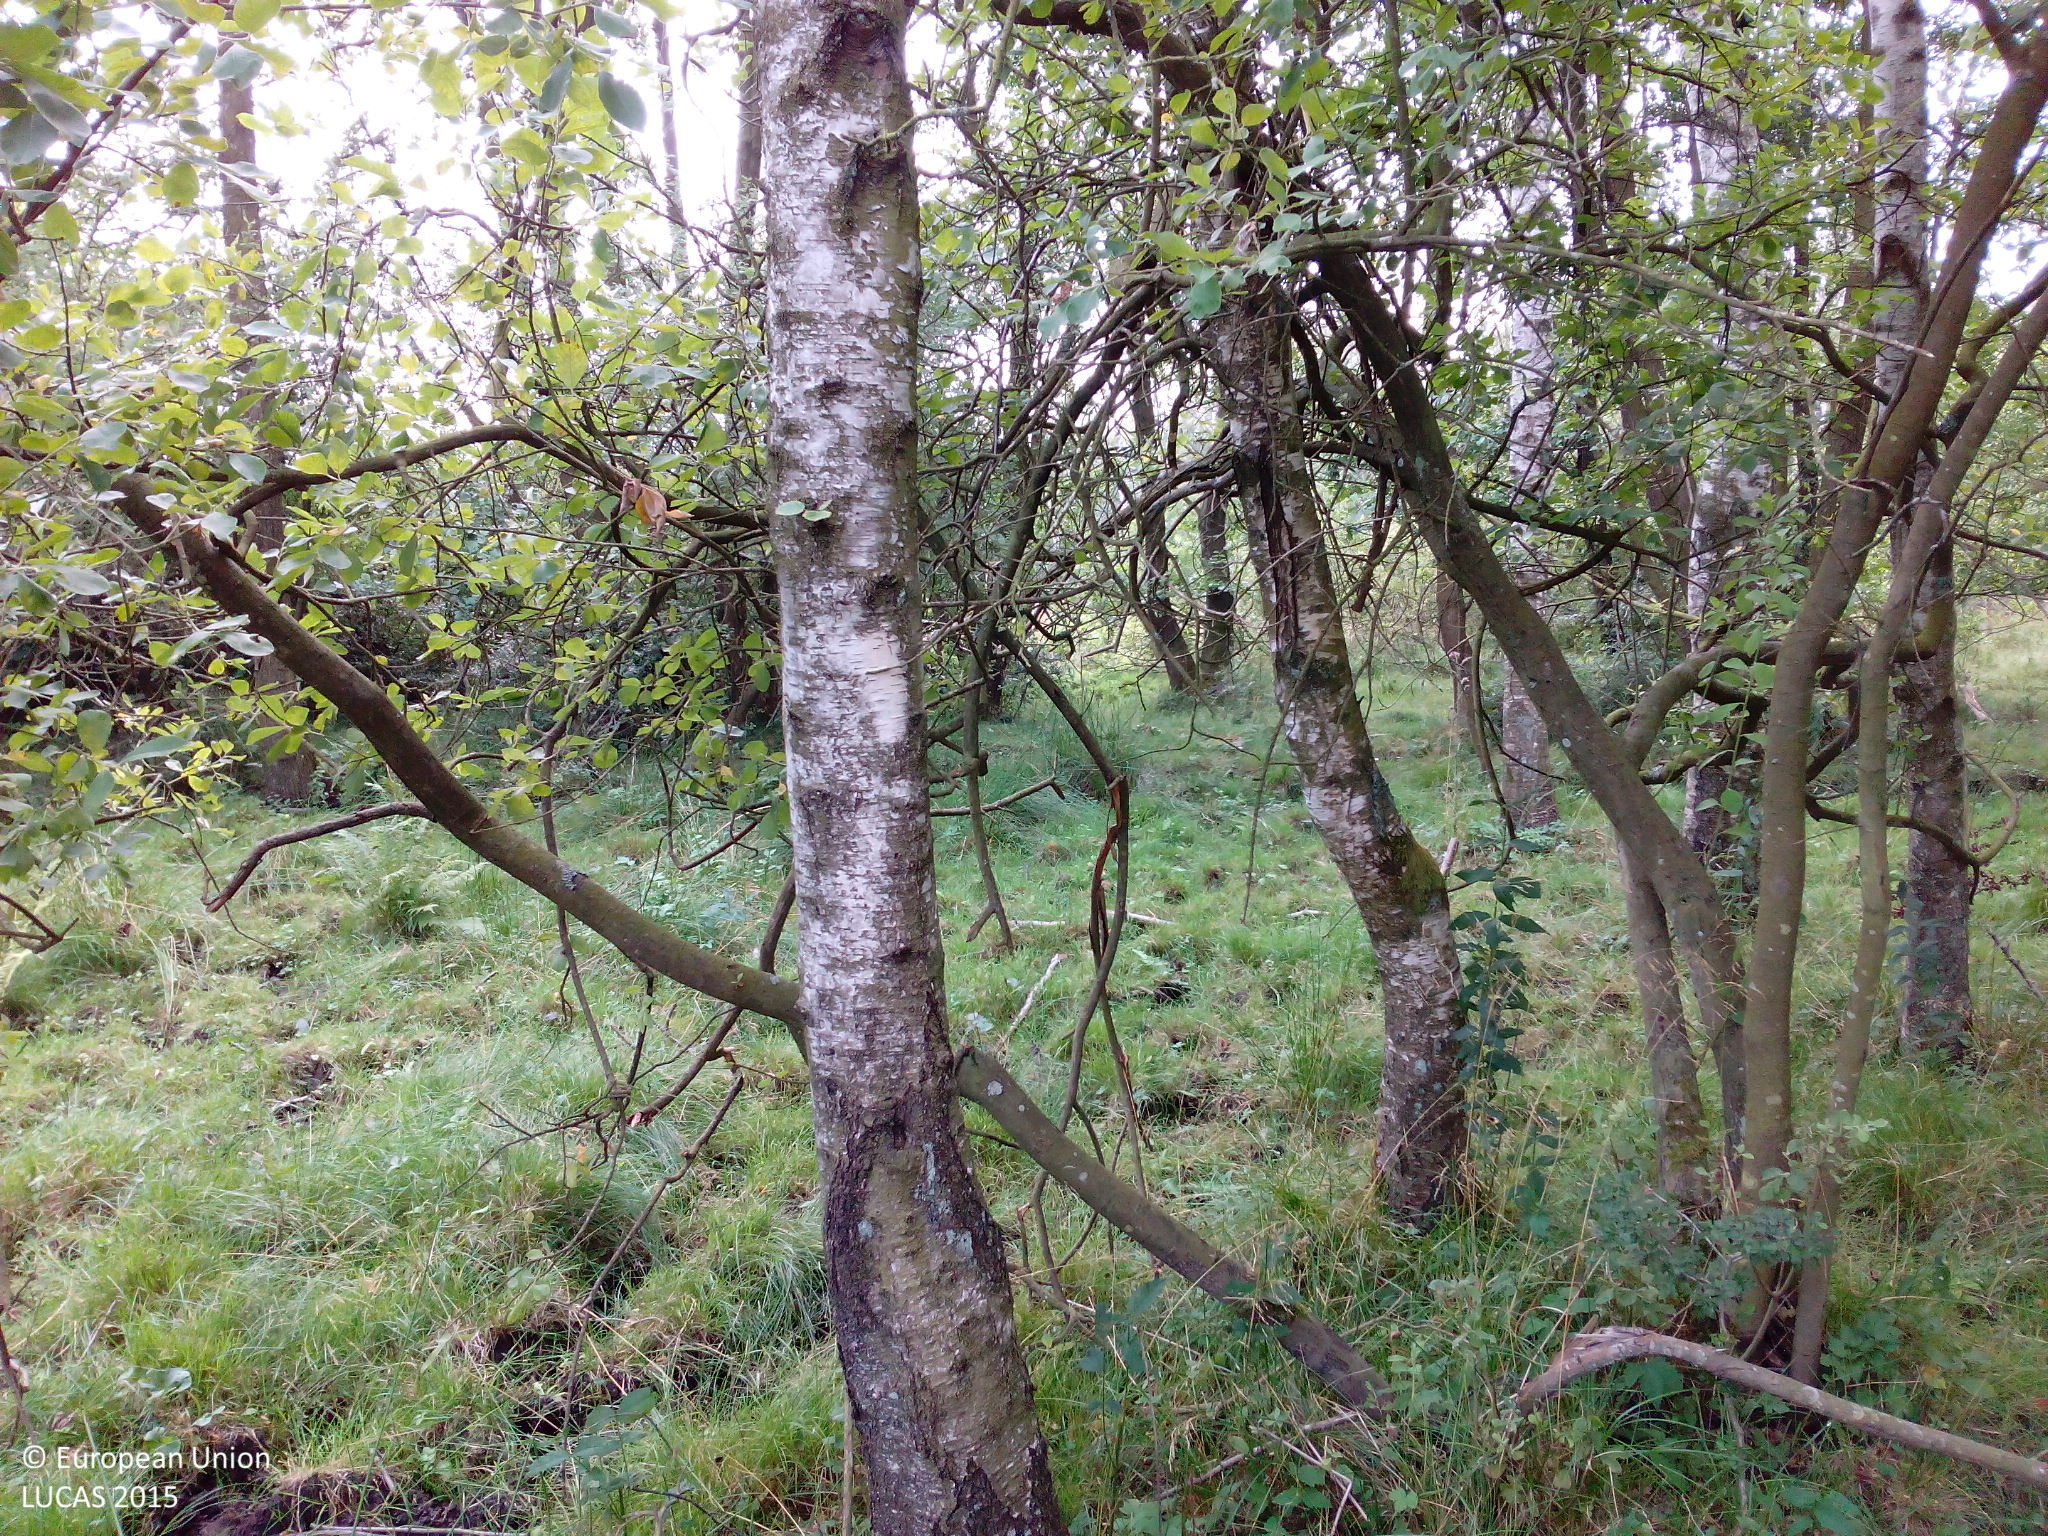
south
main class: Woodland
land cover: Broadleaved woodland
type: beech forest
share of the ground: 50 - 75 %
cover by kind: broadleaved forest trees 55 %, herbaceous plants 35 %, lichens and mosses 10 %
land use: Agriculture (excluding fallow land and kitchen gardens)
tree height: > 5 m
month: August
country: DK
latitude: 55.0997
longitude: 14.9998
